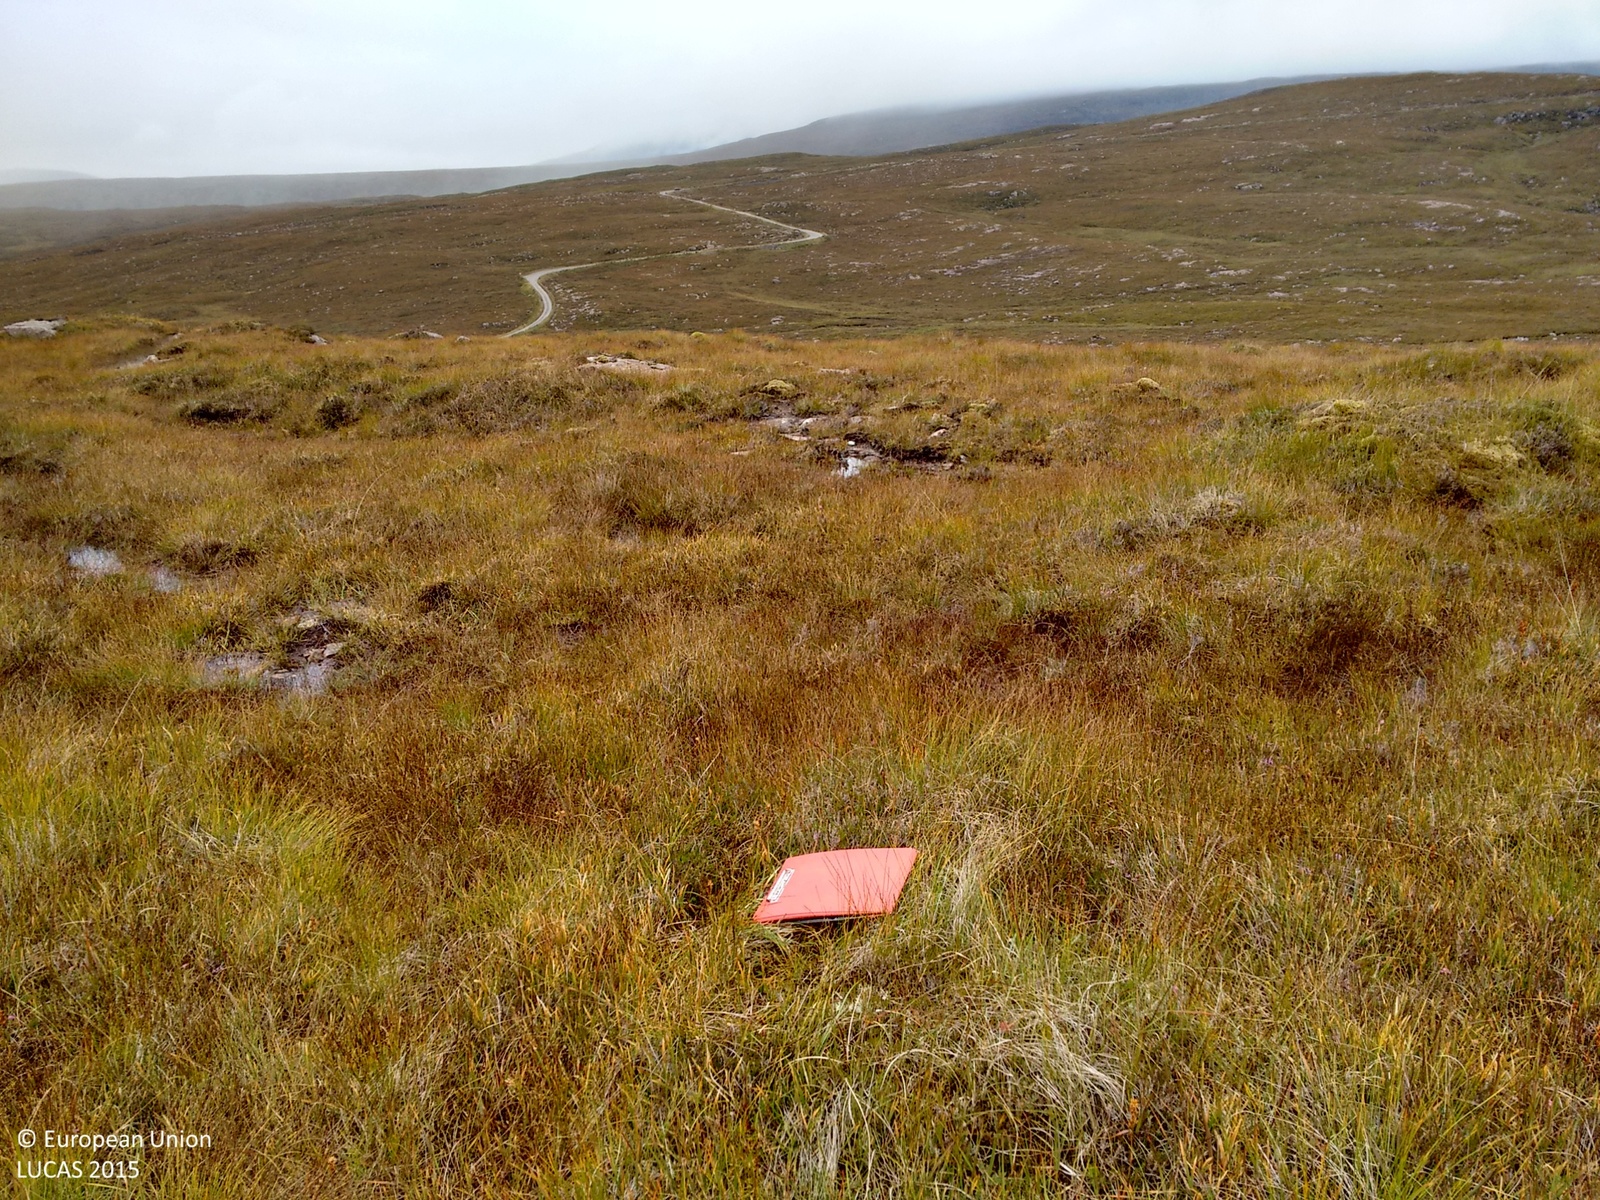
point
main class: Shrubland
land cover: Shrubland without tree cover
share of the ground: > 75 %
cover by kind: herbaceous plants 55 %, shrubs 40 %
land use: Agriculture (excluding fallow land and kitchen gardens)
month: September
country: GB
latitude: 57.4277
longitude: -5.7606
